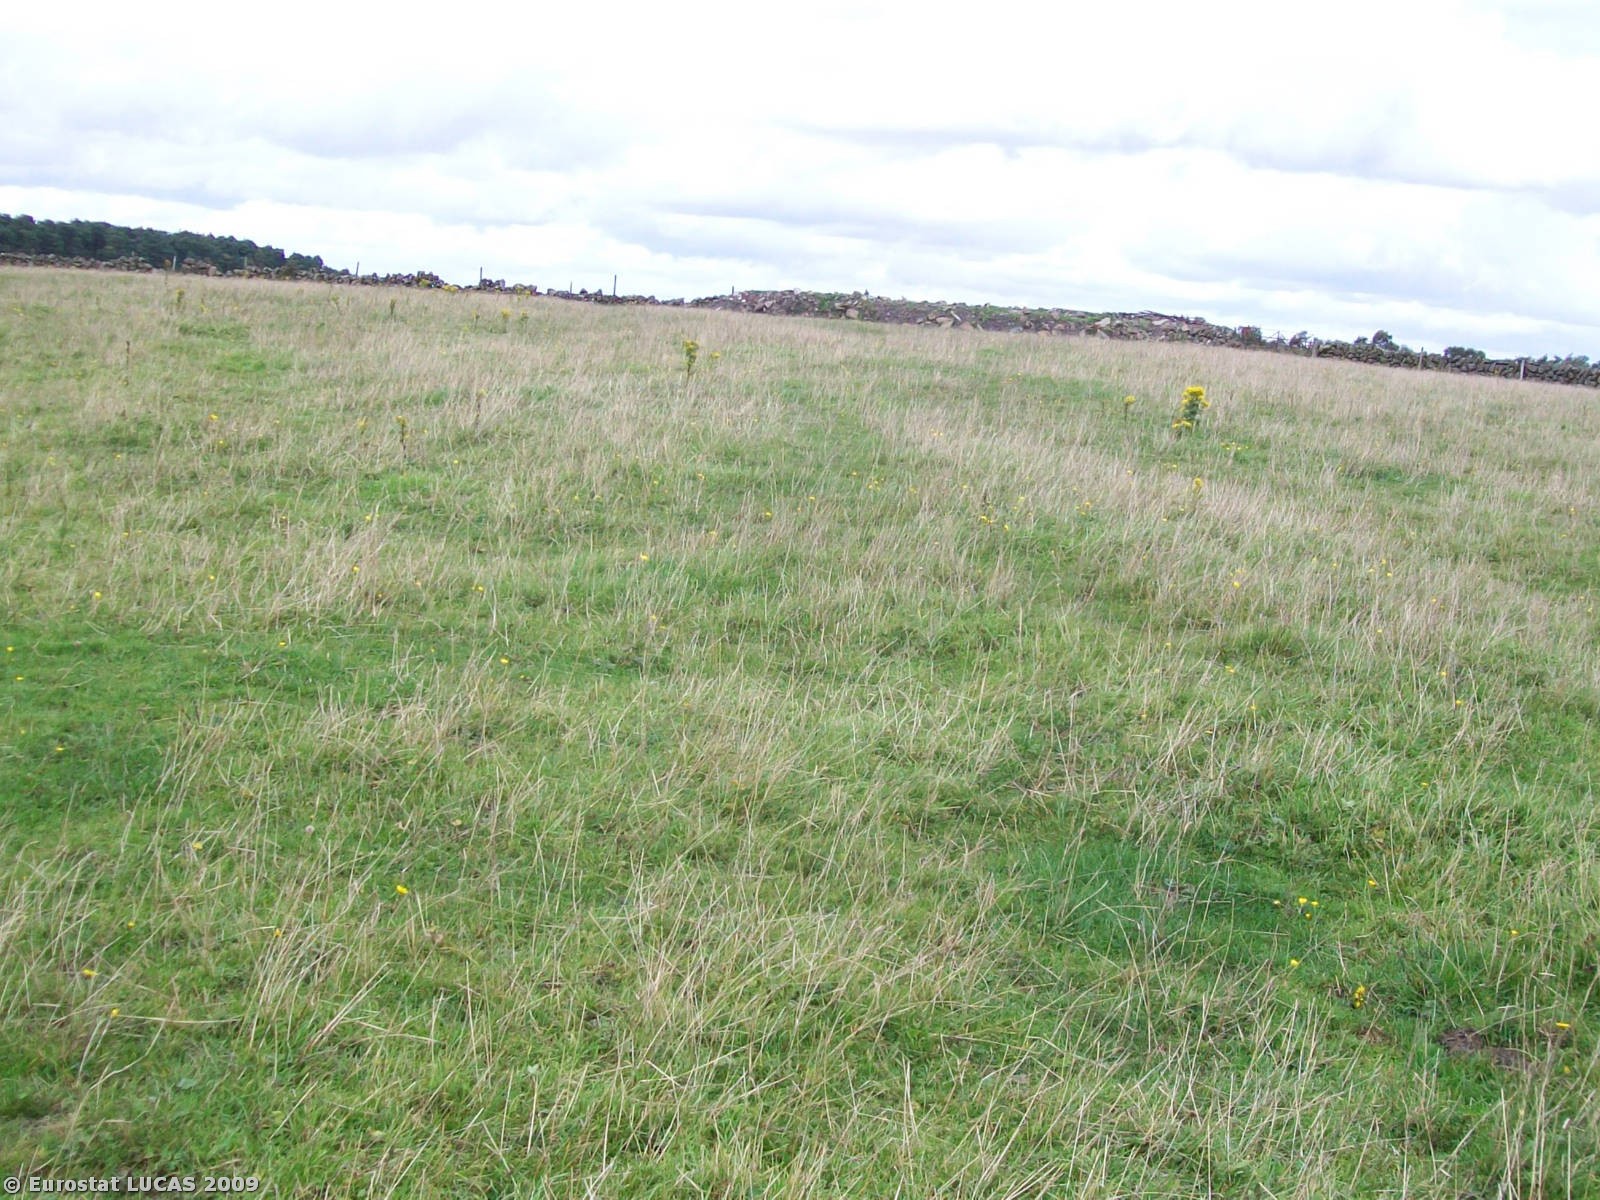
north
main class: Grassland
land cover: Grassland without tree/shrub cover
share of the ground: < 10 %
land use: Agriculture (excluding fallow land and kitchen gardens)
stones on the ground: < 10 %
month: September
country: GB
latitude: 55.4318
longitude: -4.3355
